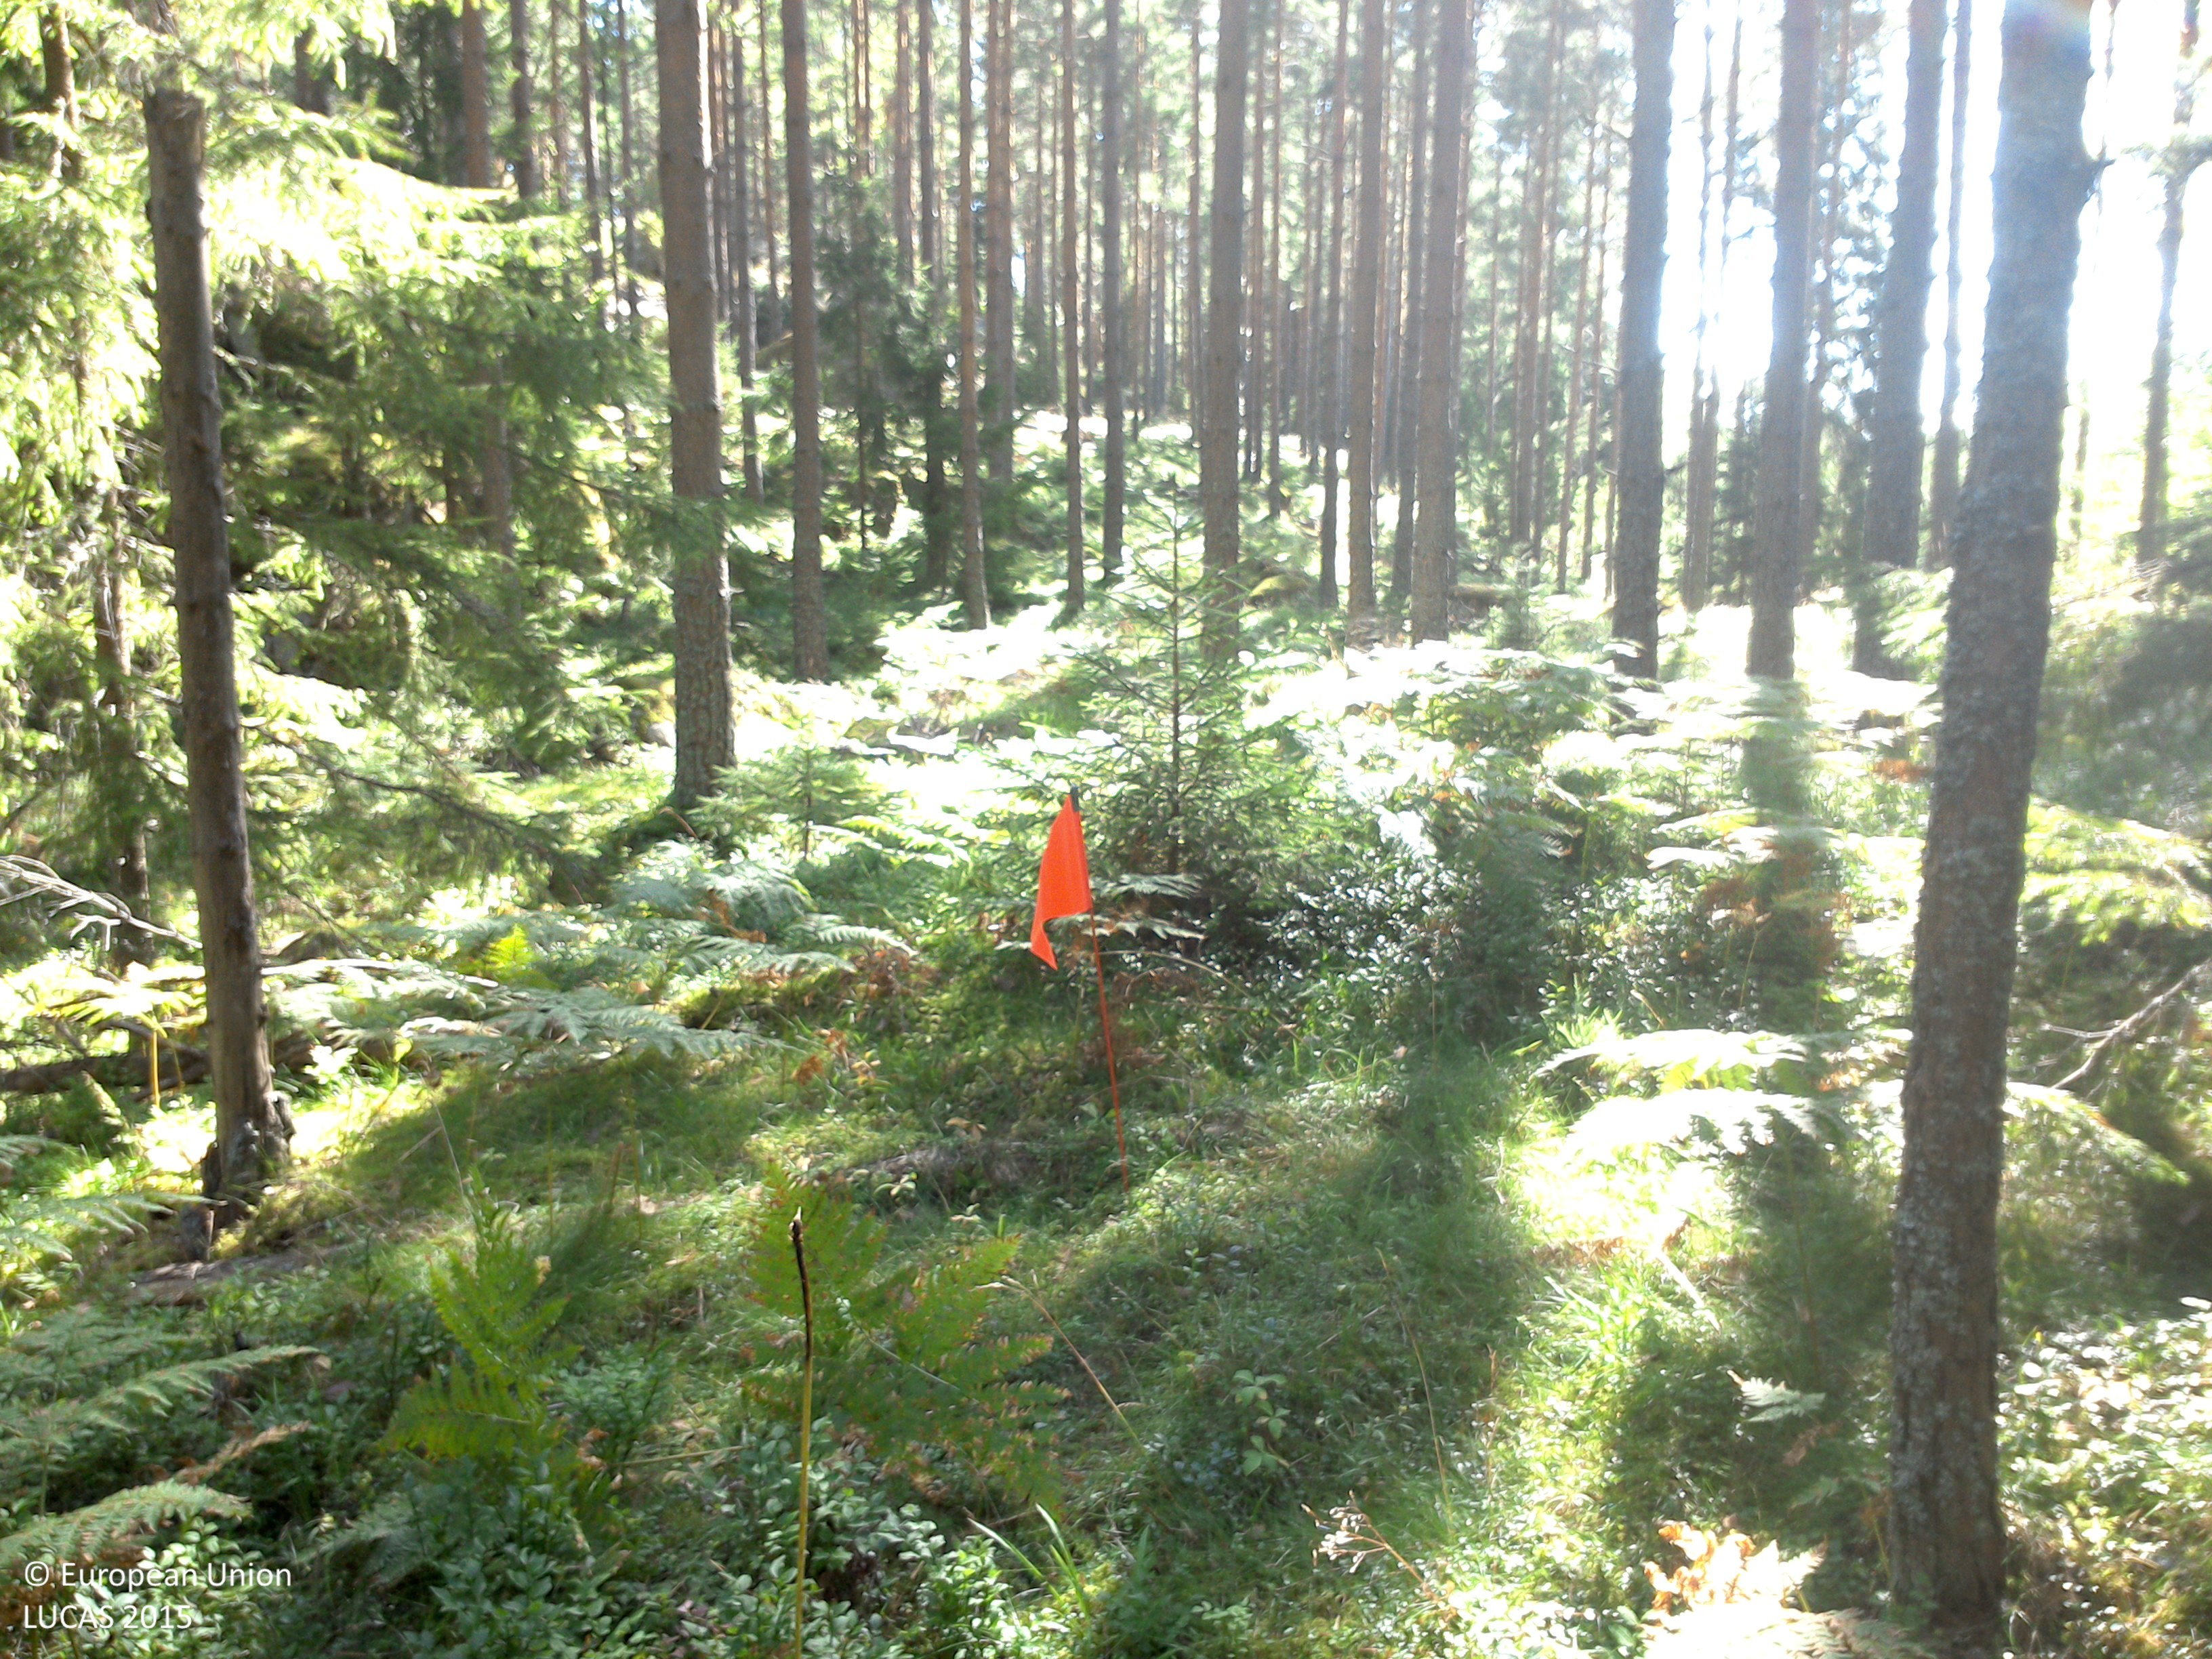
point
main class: Woodland
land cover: Pine dominated coniferous woodland
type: boreal forest
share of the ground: 25 - 50 %
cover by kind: coniferous forest trees 40 %, herbaceous plants 40 %, lichens and mosses 20 %
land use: Forestry
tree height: > 5 m
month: August
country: SE
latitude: 57.8777
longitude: 15.3746
